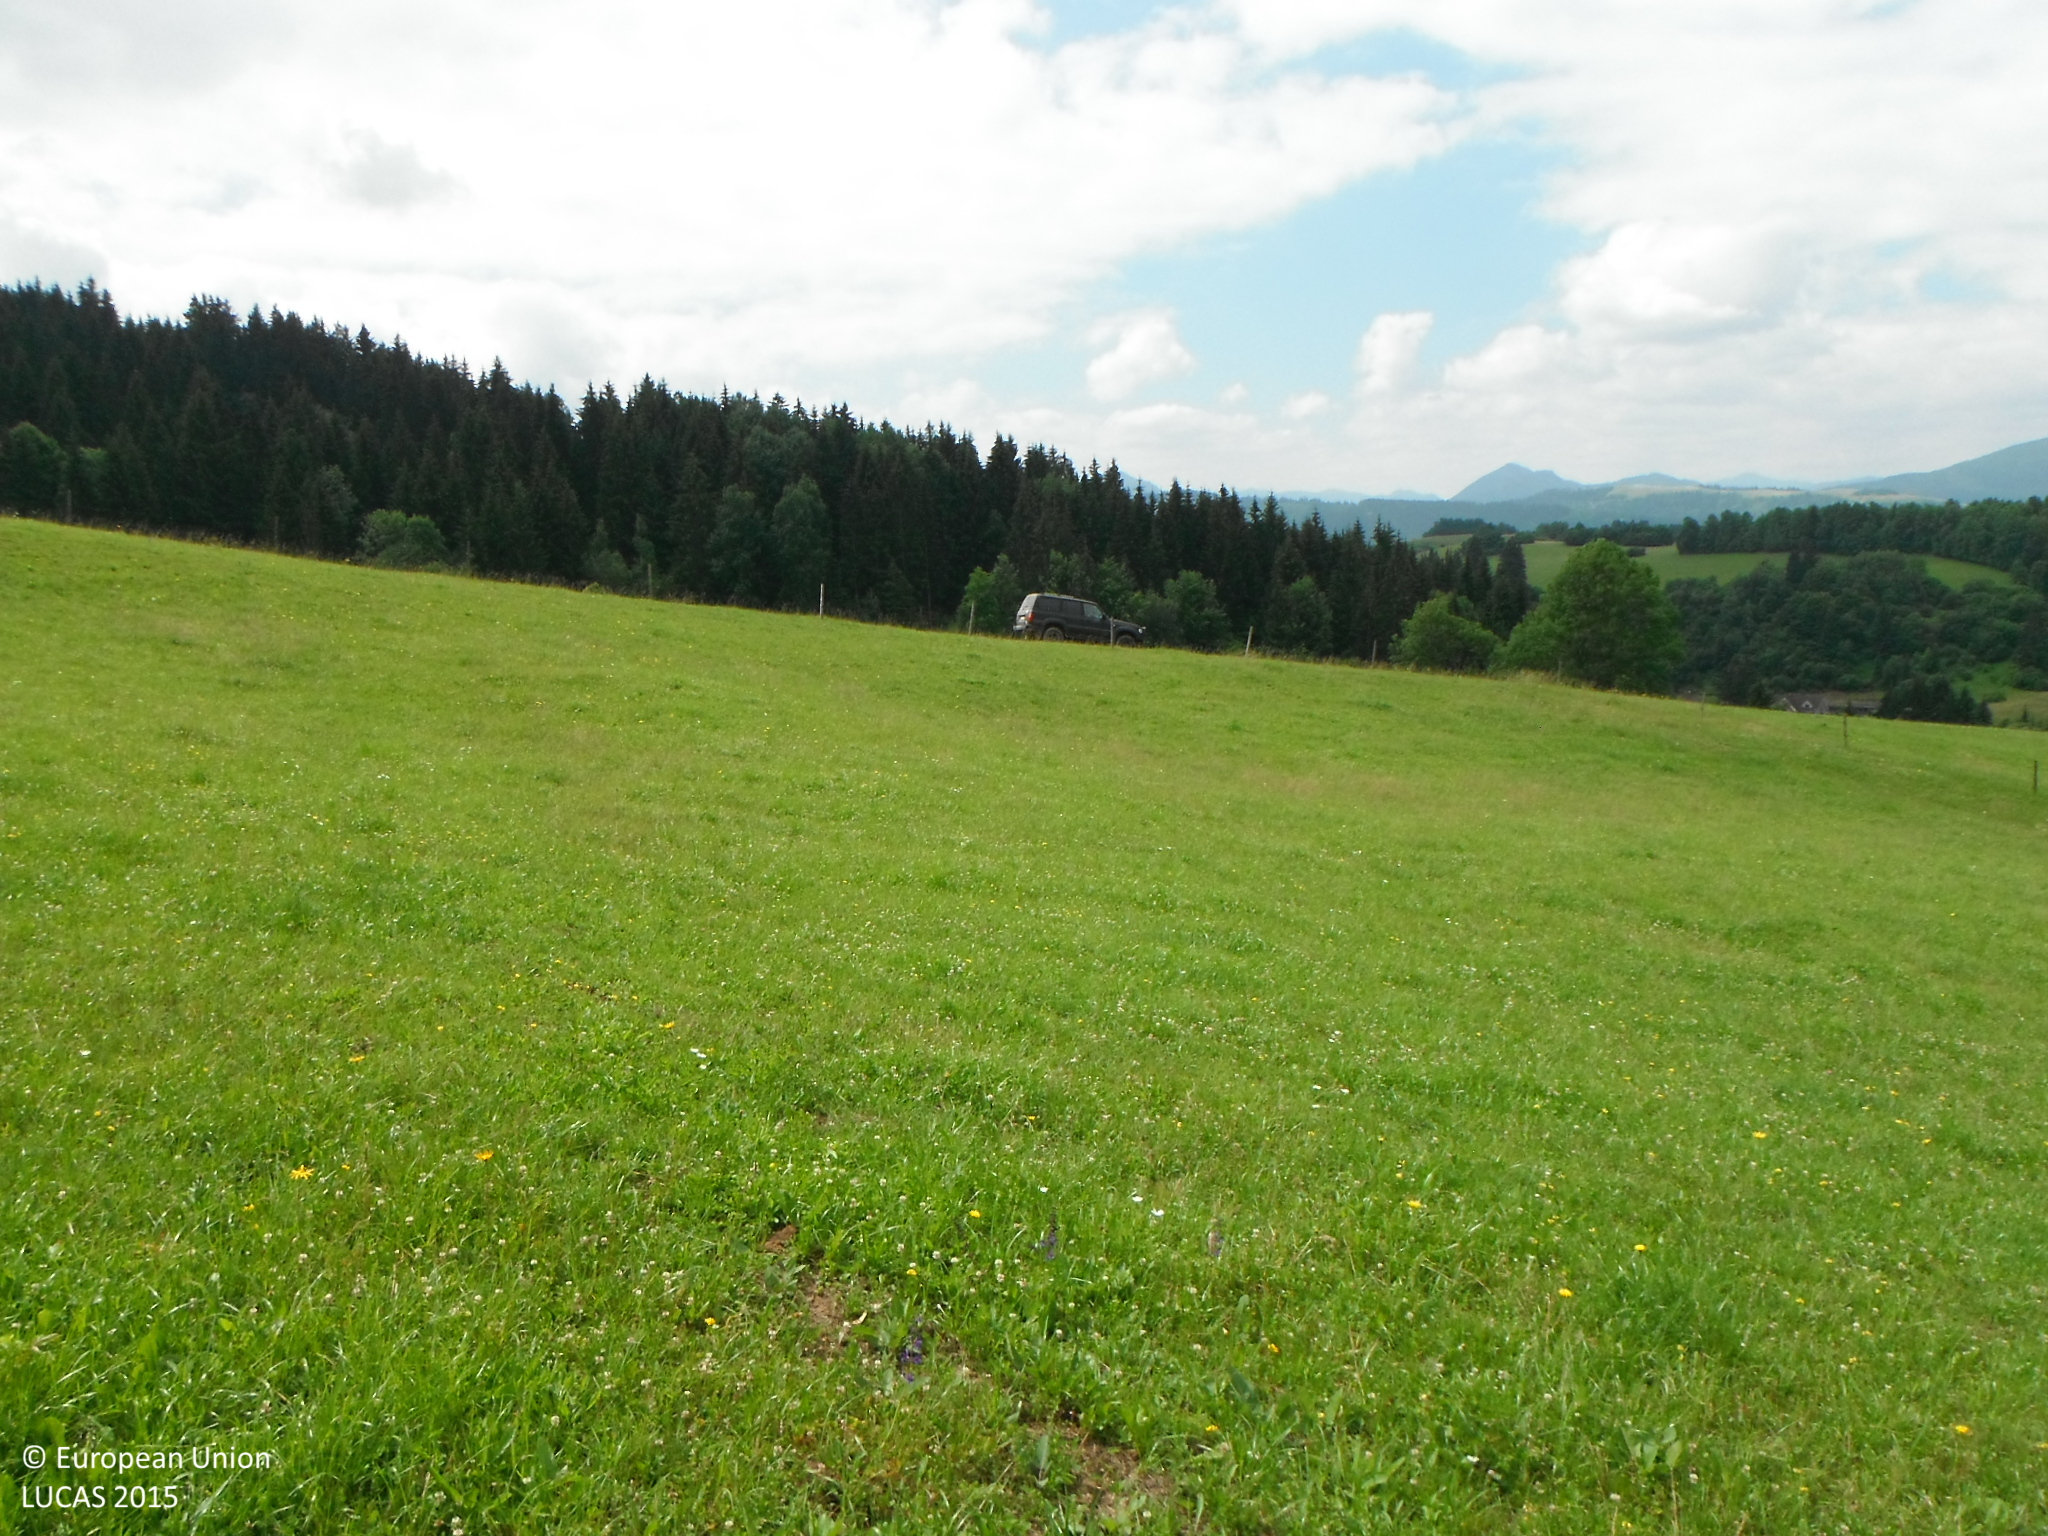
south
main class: Grassland
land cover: Grassland without tree/shrub cover
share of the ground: > 75 %
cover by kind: herbaceous plants 100 %
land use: Agriculture (excluding fallow land and kitchen gardens)
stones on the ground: < 10 %
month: June
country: SK
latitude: 49.2269
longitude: 19.2655
